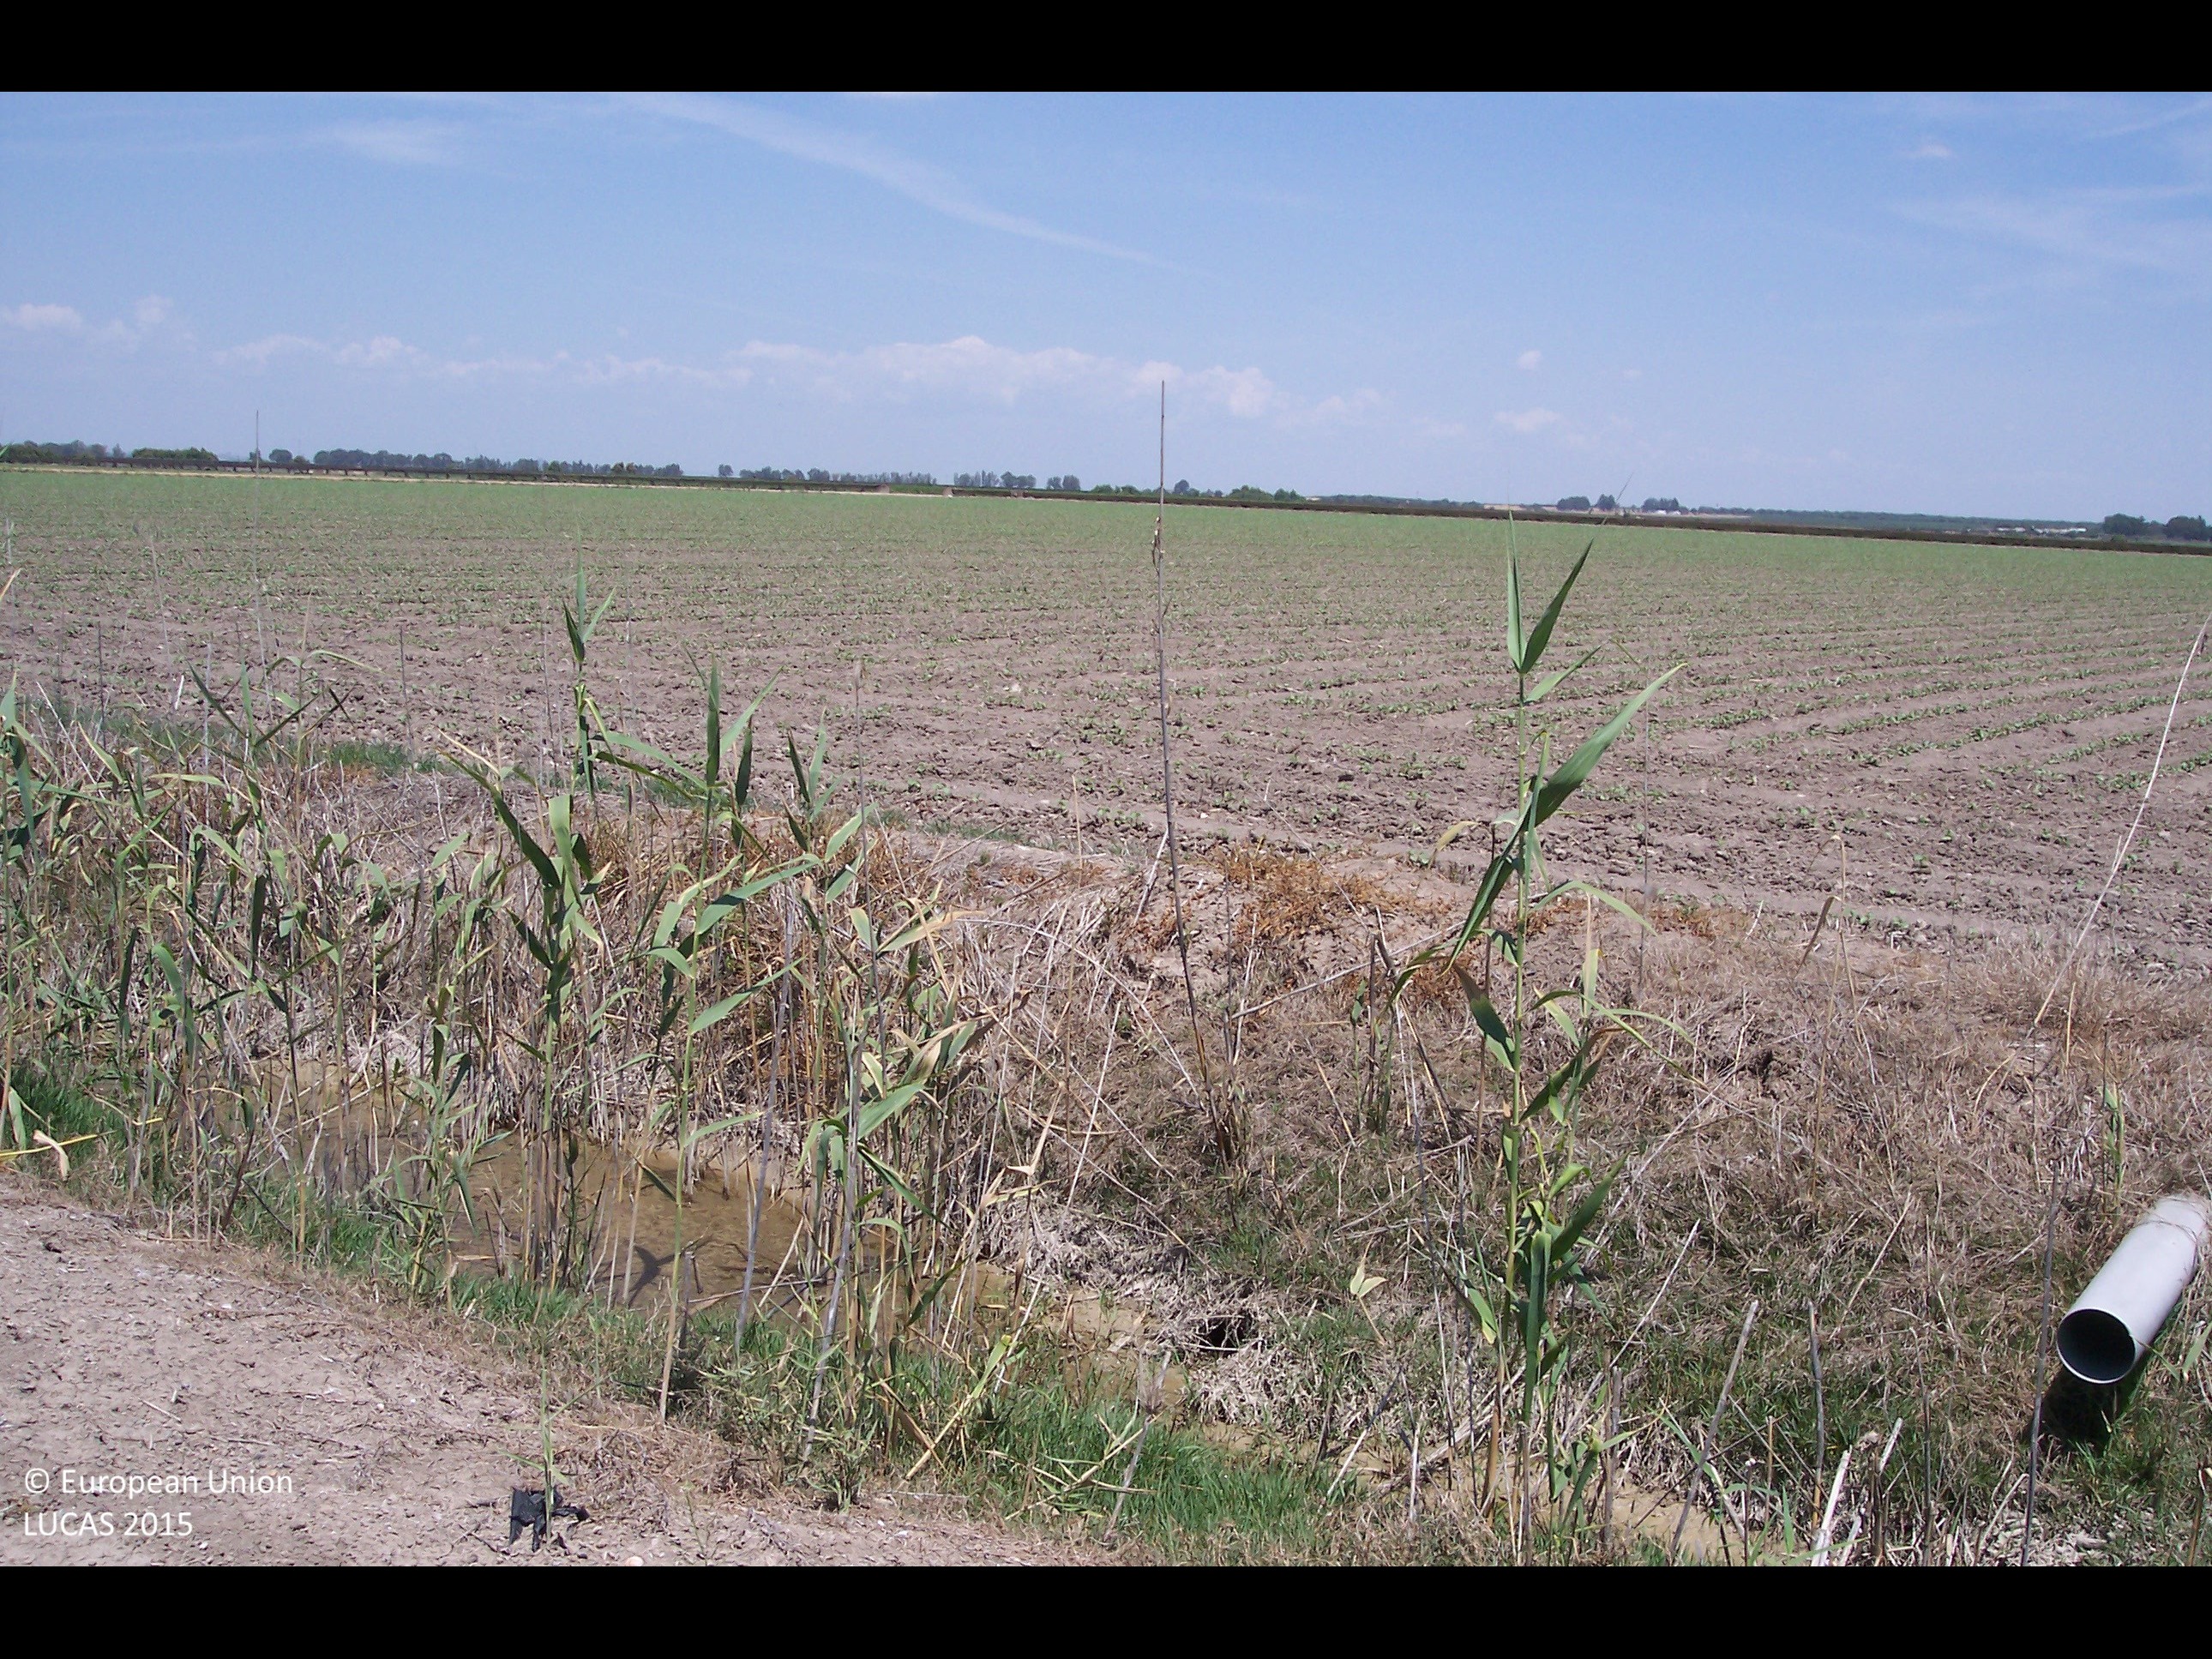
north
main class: Cropland
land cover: Sunflower
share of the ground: > 75 %
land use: Agriculture (excluding fallow land and kitchen gardens)
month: May
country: ES
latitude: 37.1861
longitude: -6.0502
